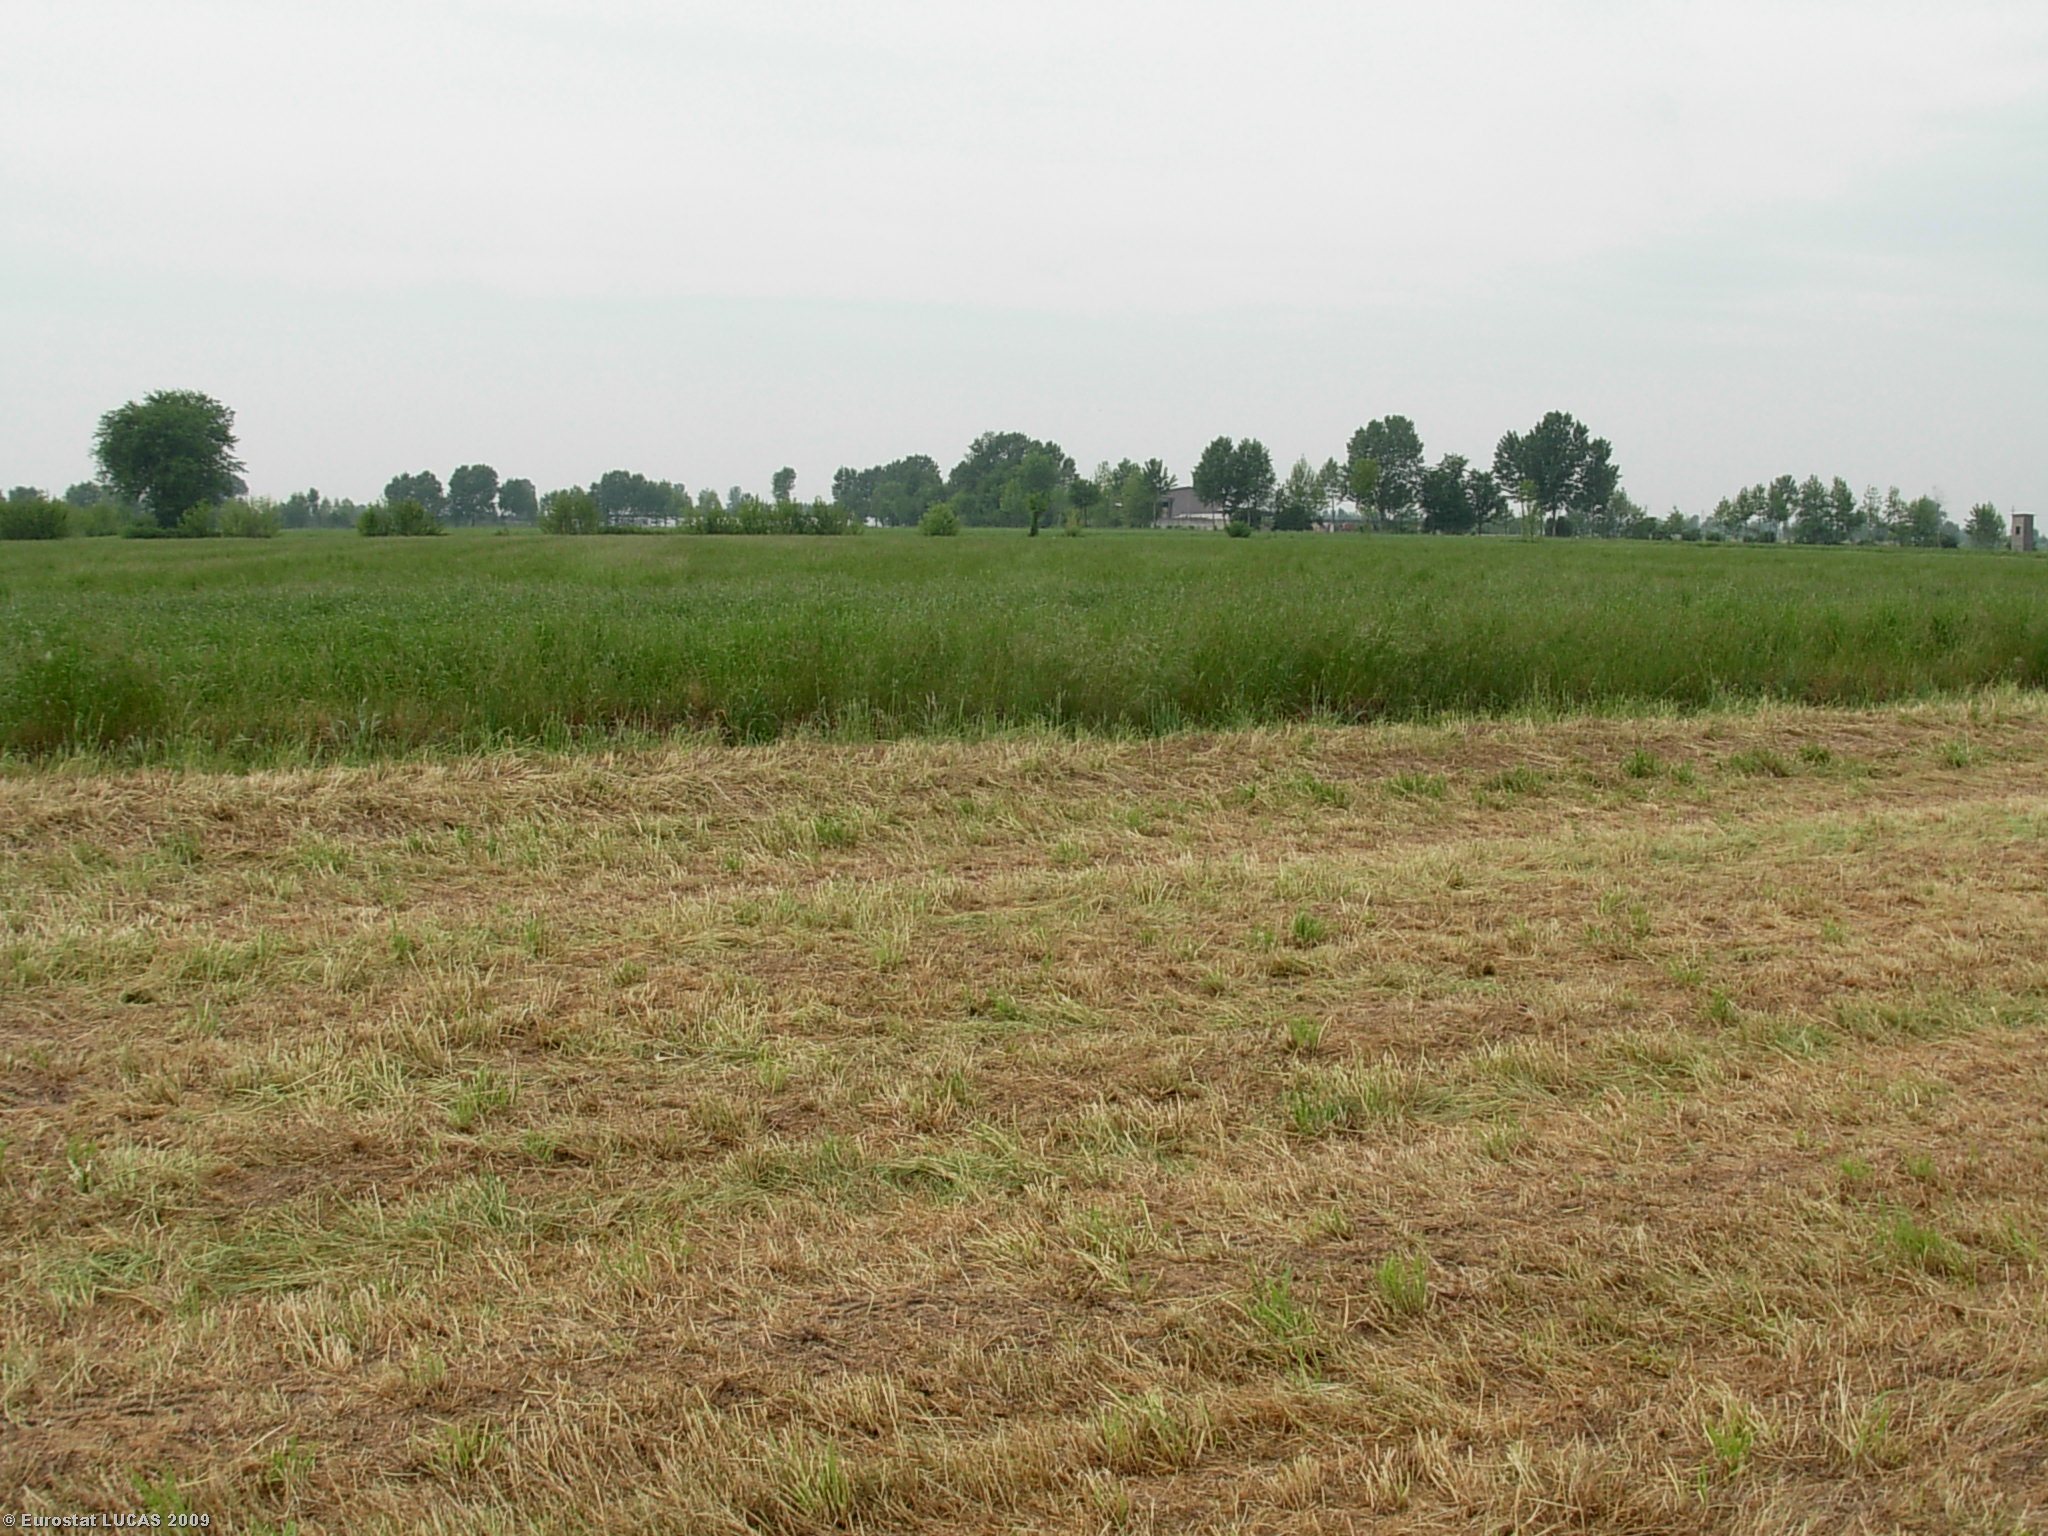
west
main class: Cropland
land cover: Temporary grasslands
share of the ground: 50 - 75 %
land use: Agriculture (excluding fallow land and kitchen gardens)
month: May
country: IT
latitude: 45.3419
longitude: 10.2675
